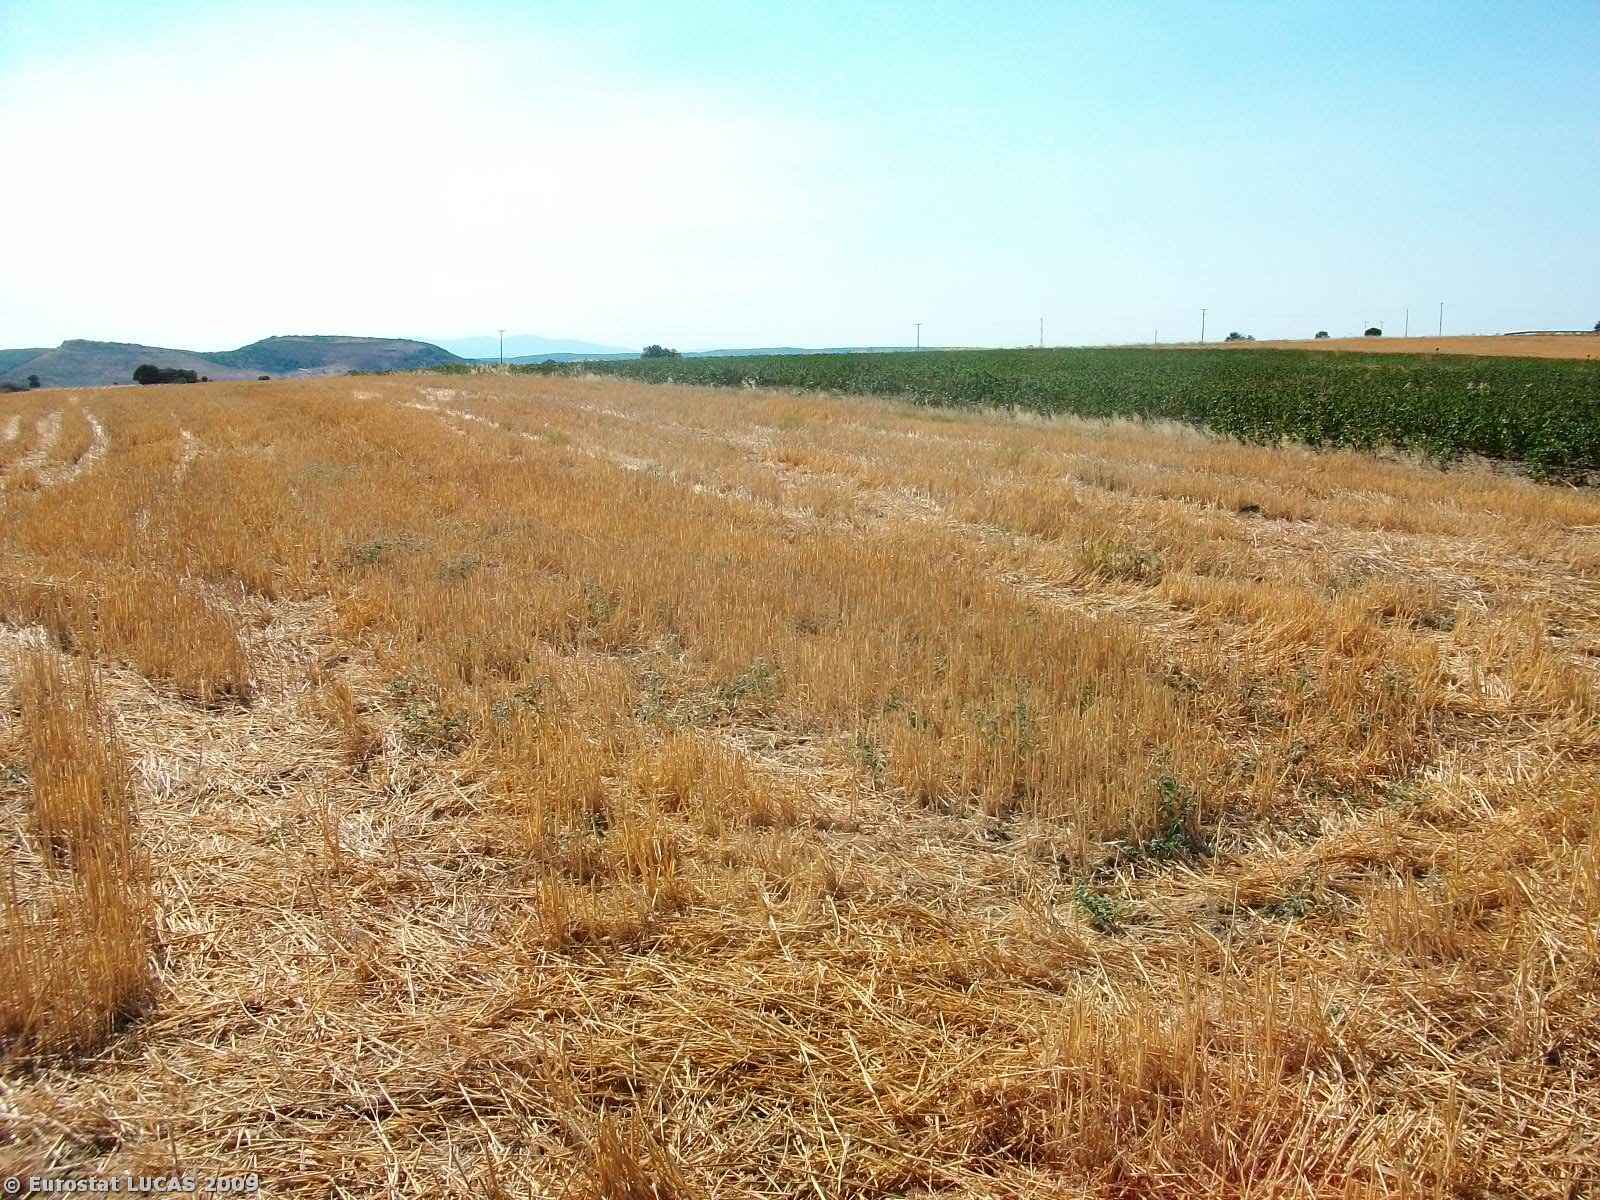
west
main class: Artificial land
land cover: Non built-up linear features
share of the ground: < 10 %
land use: Road transport
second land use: Agriculture (excluding fallow land and kitchen gardens)
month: August
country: GR
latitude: 41.3846
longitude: 26.3734
